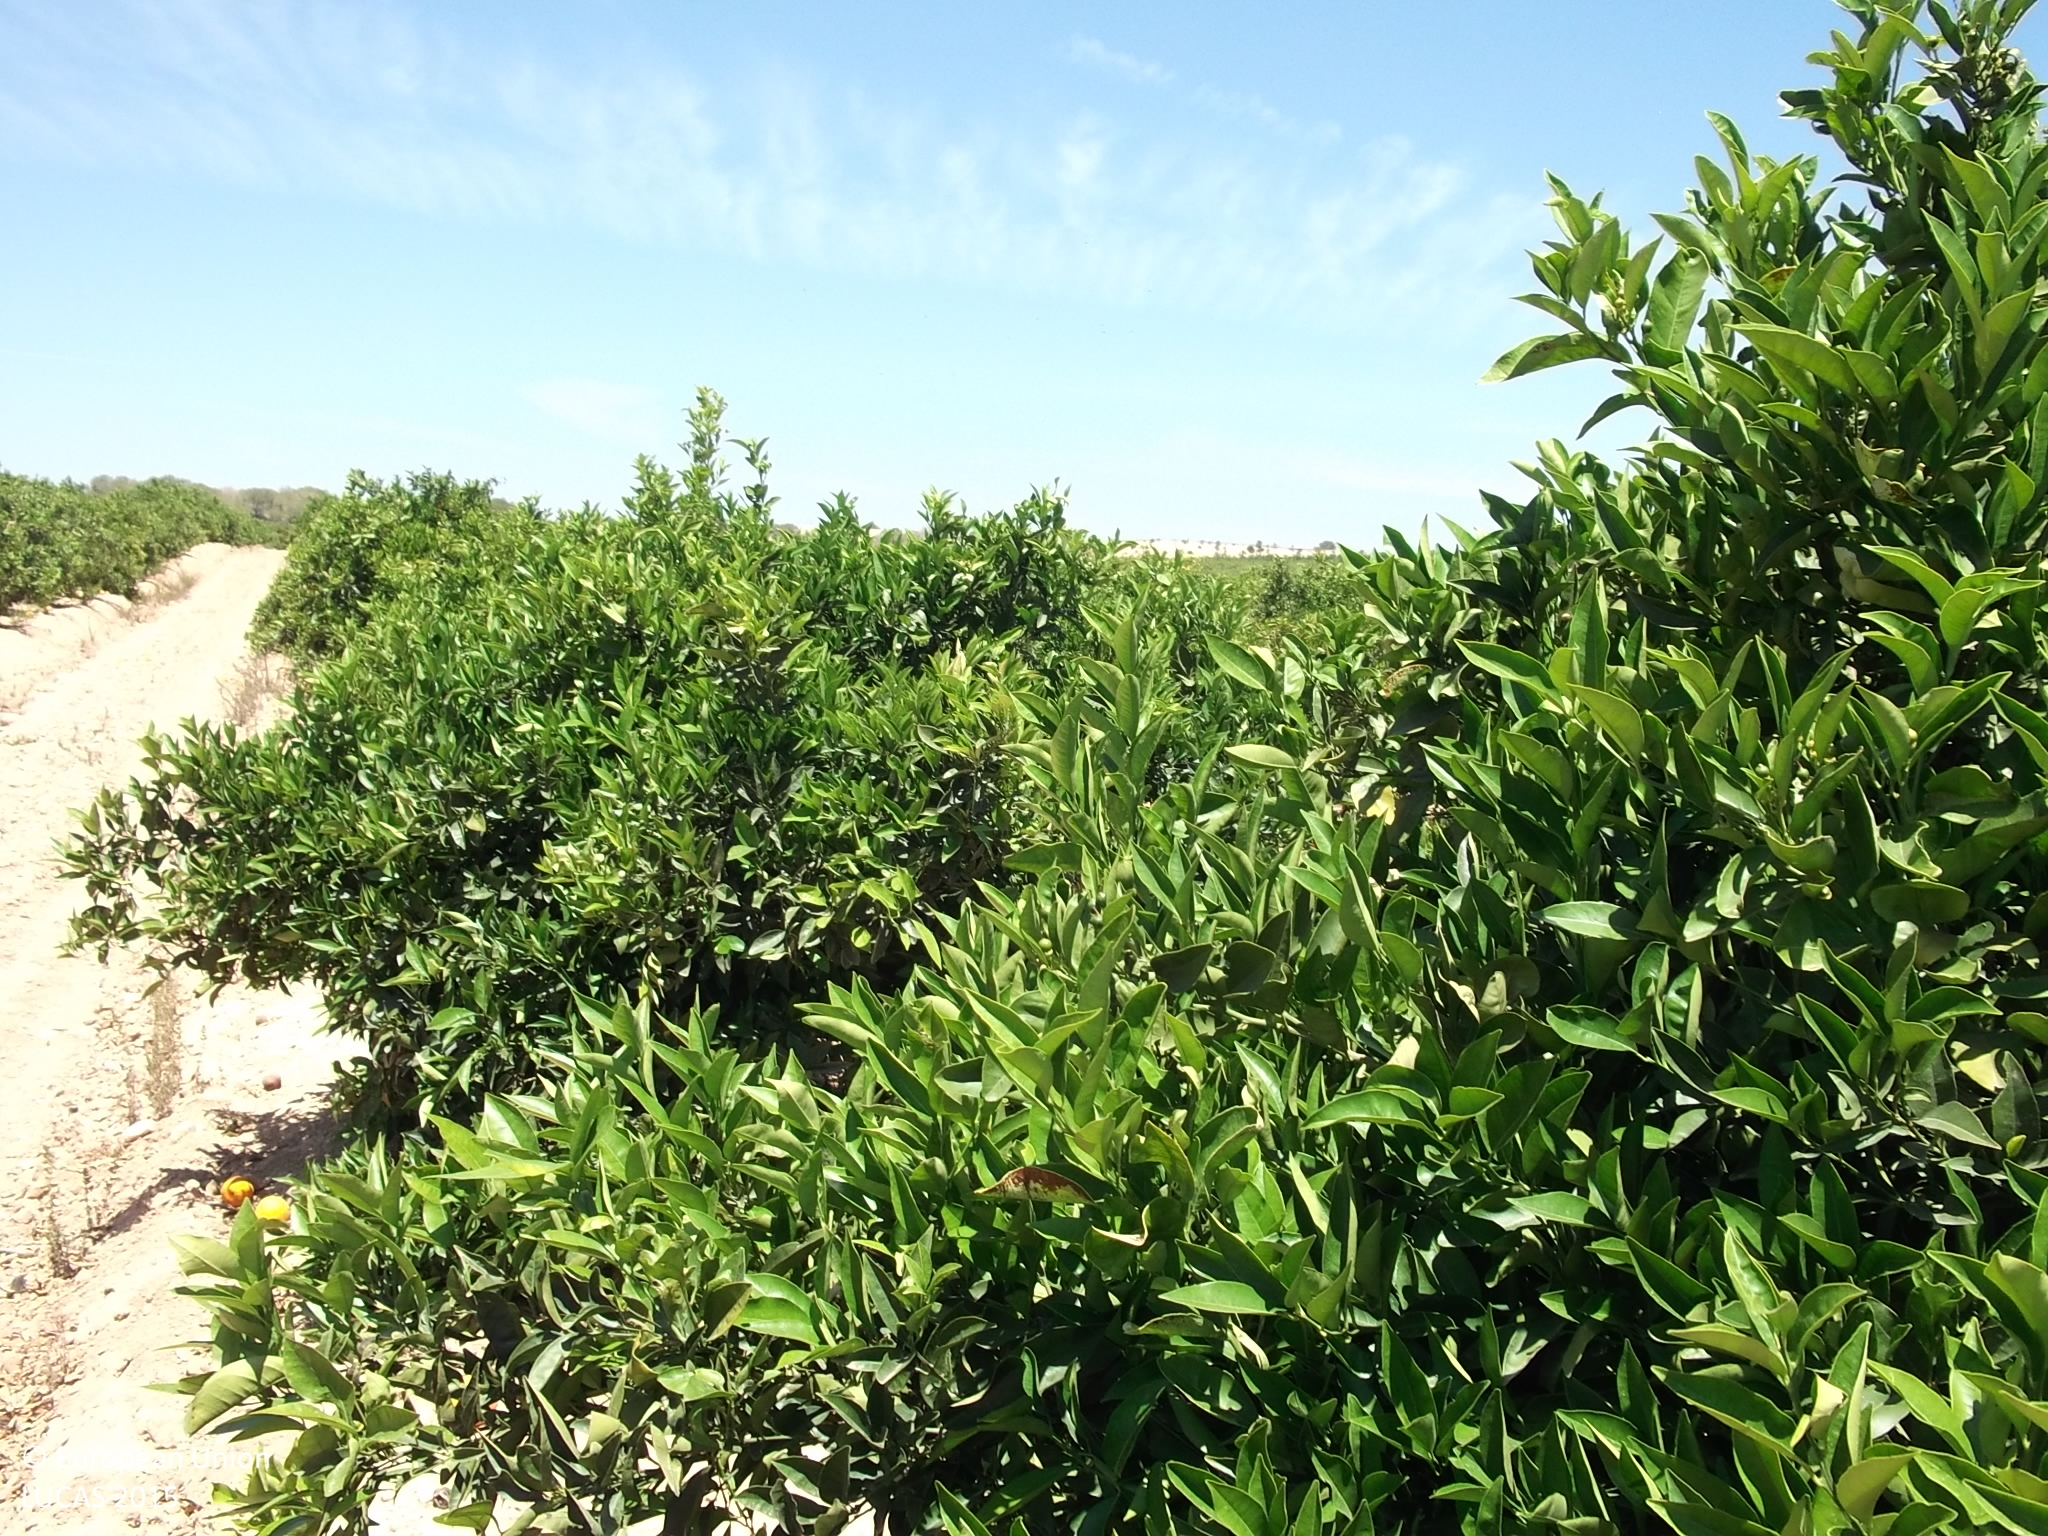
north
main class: Cropland
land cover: Oranges
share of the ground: 10 - 25 %
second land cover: Other bare soil
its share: > 75 %
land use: Agriculture (excluding fallow land and kitchen gardens)
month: May
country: ES
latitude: 37.8962
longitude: -0.8189
